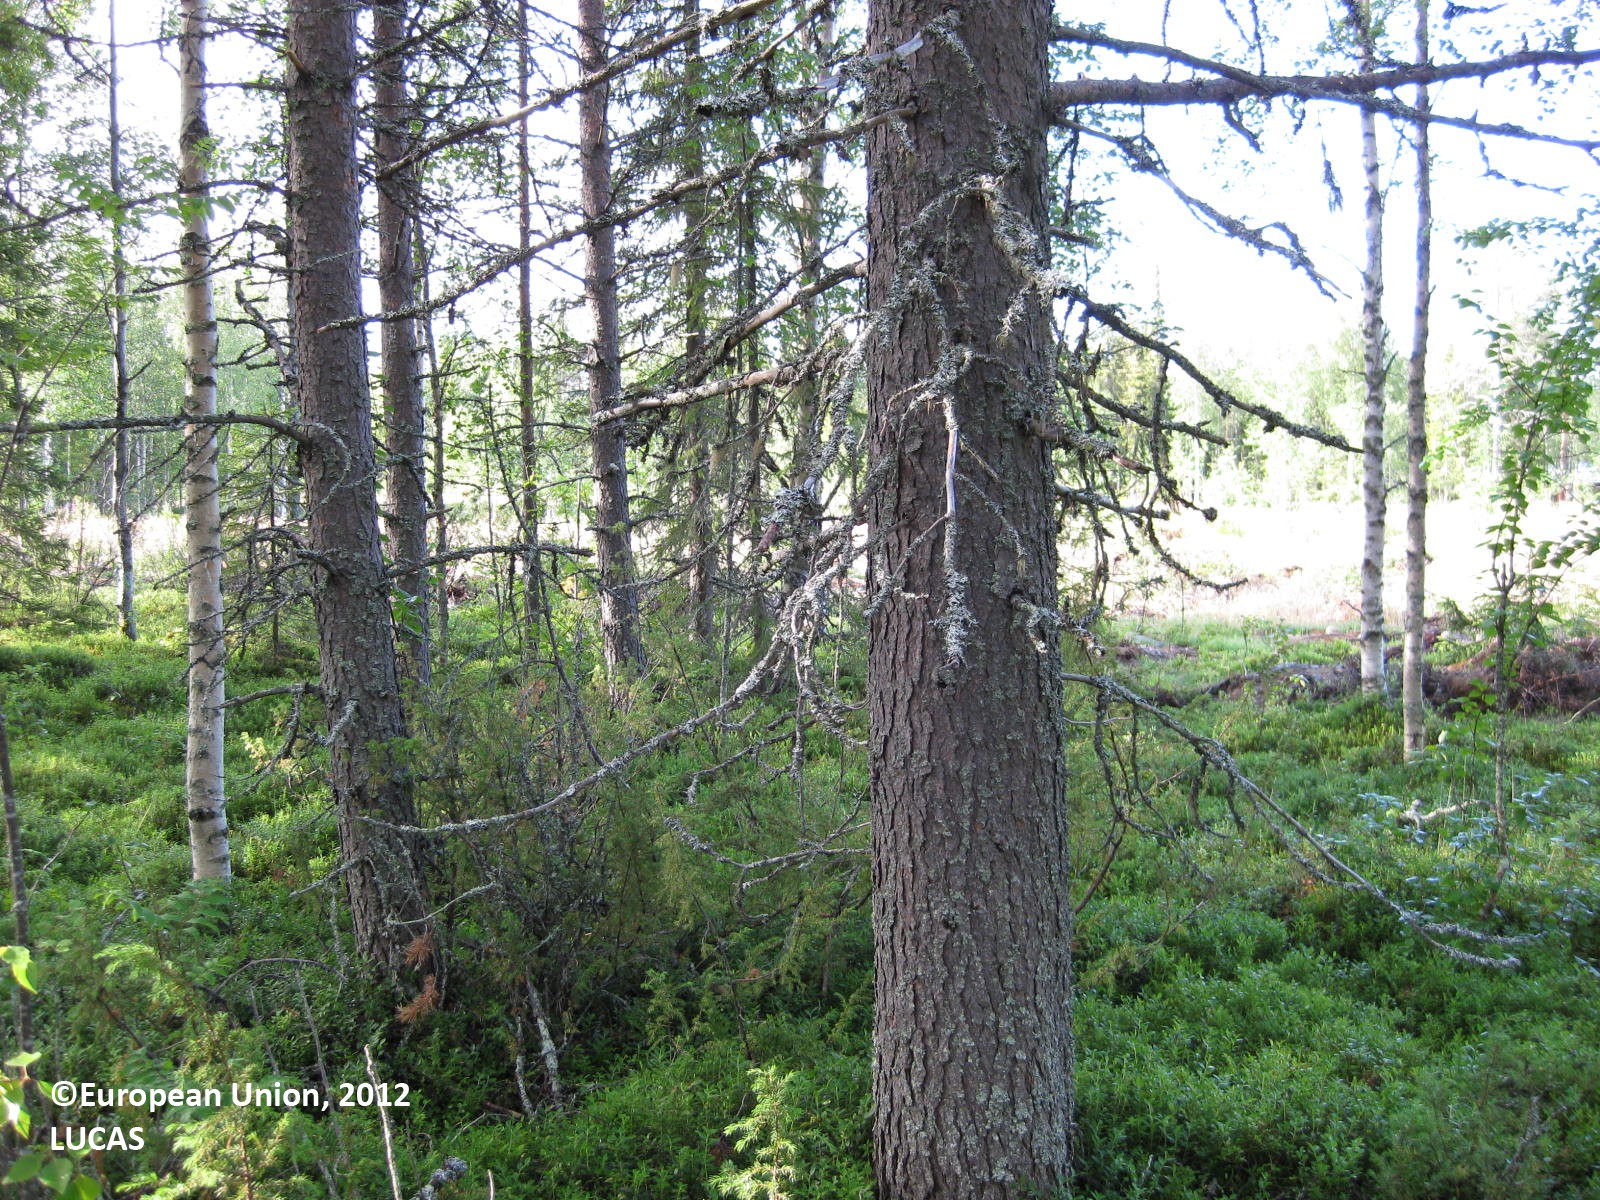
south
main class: Woodland
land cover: Pine dominated mixed woodland
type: boreal forest
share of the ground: 50 - 75 %
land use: Forestry
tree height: > 5 m
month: July
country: FI
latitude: 65.7333
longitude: 28.5870
